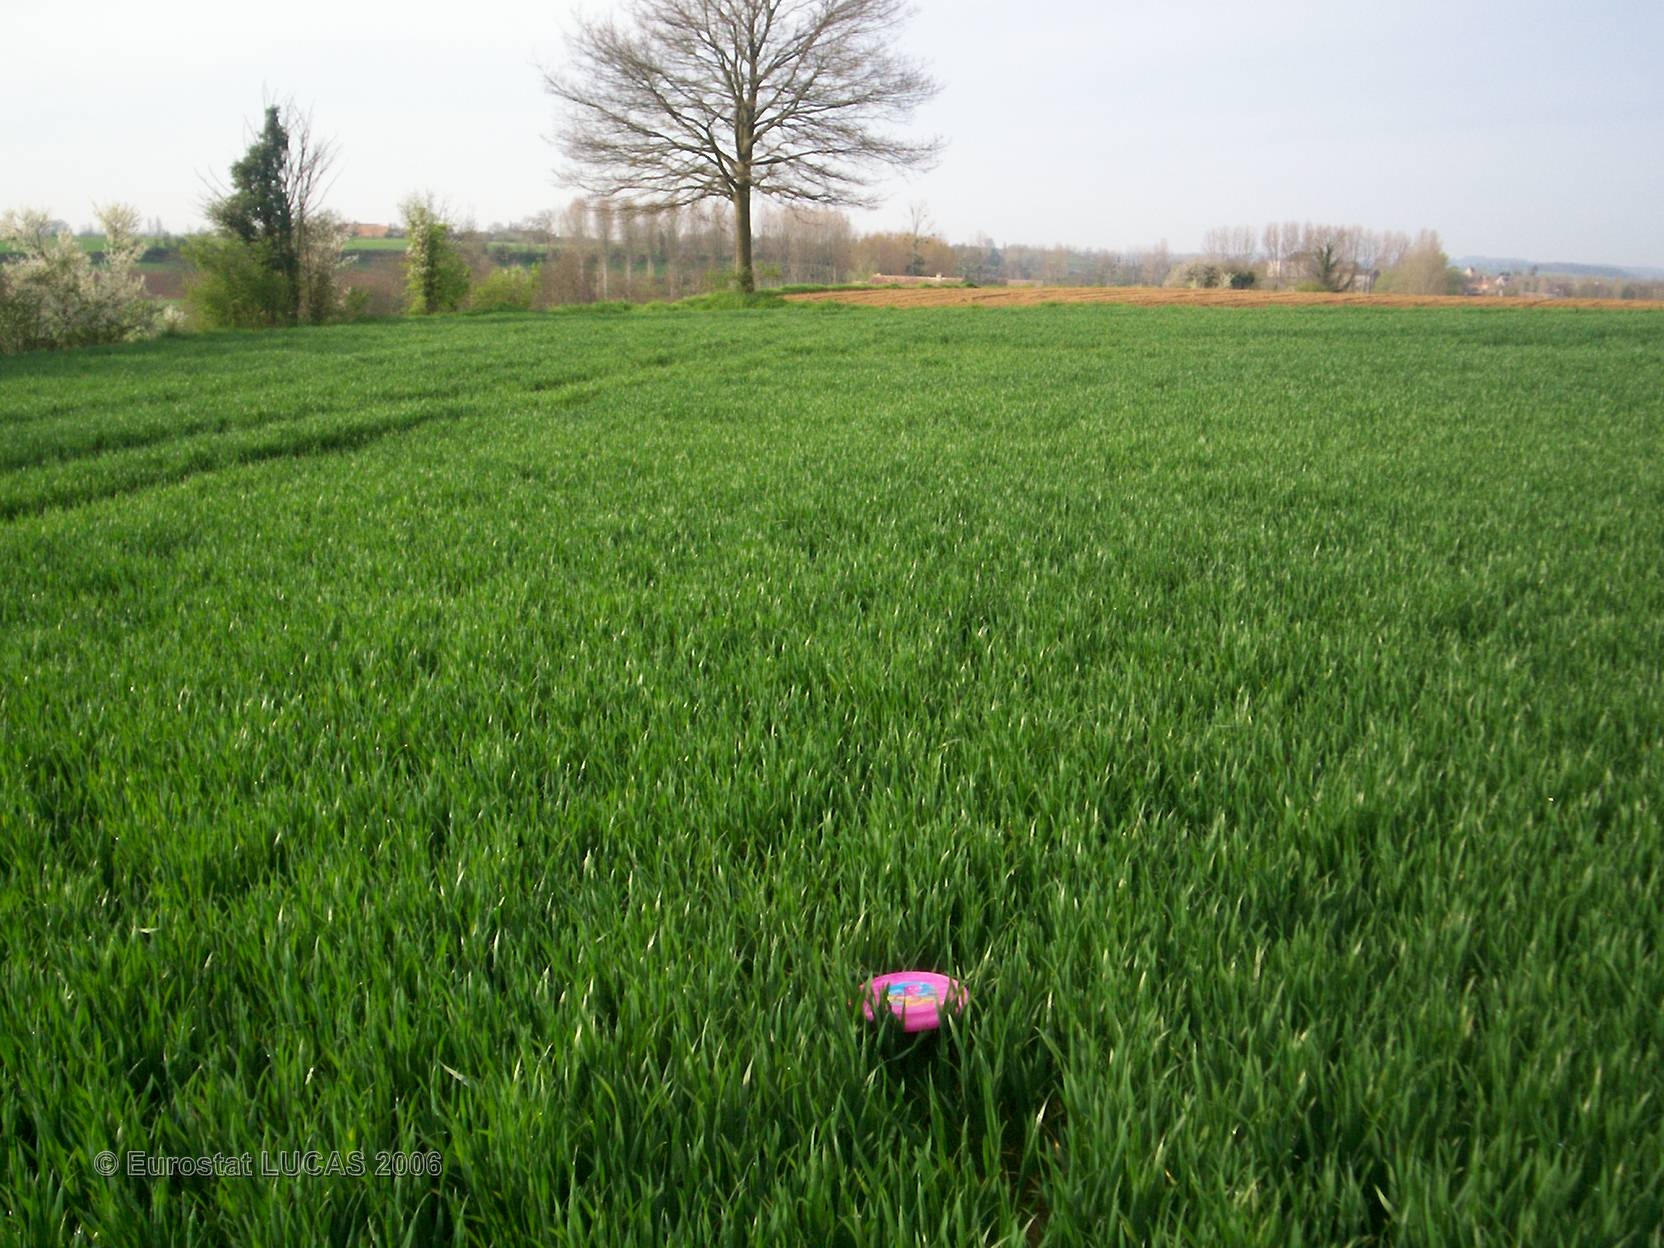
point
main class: Cropland
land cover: Common wheat
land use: Agriculture (excluding fallow land and kitchen gardens)
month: April
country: FR
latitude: 48.2685
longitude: 0.1239
